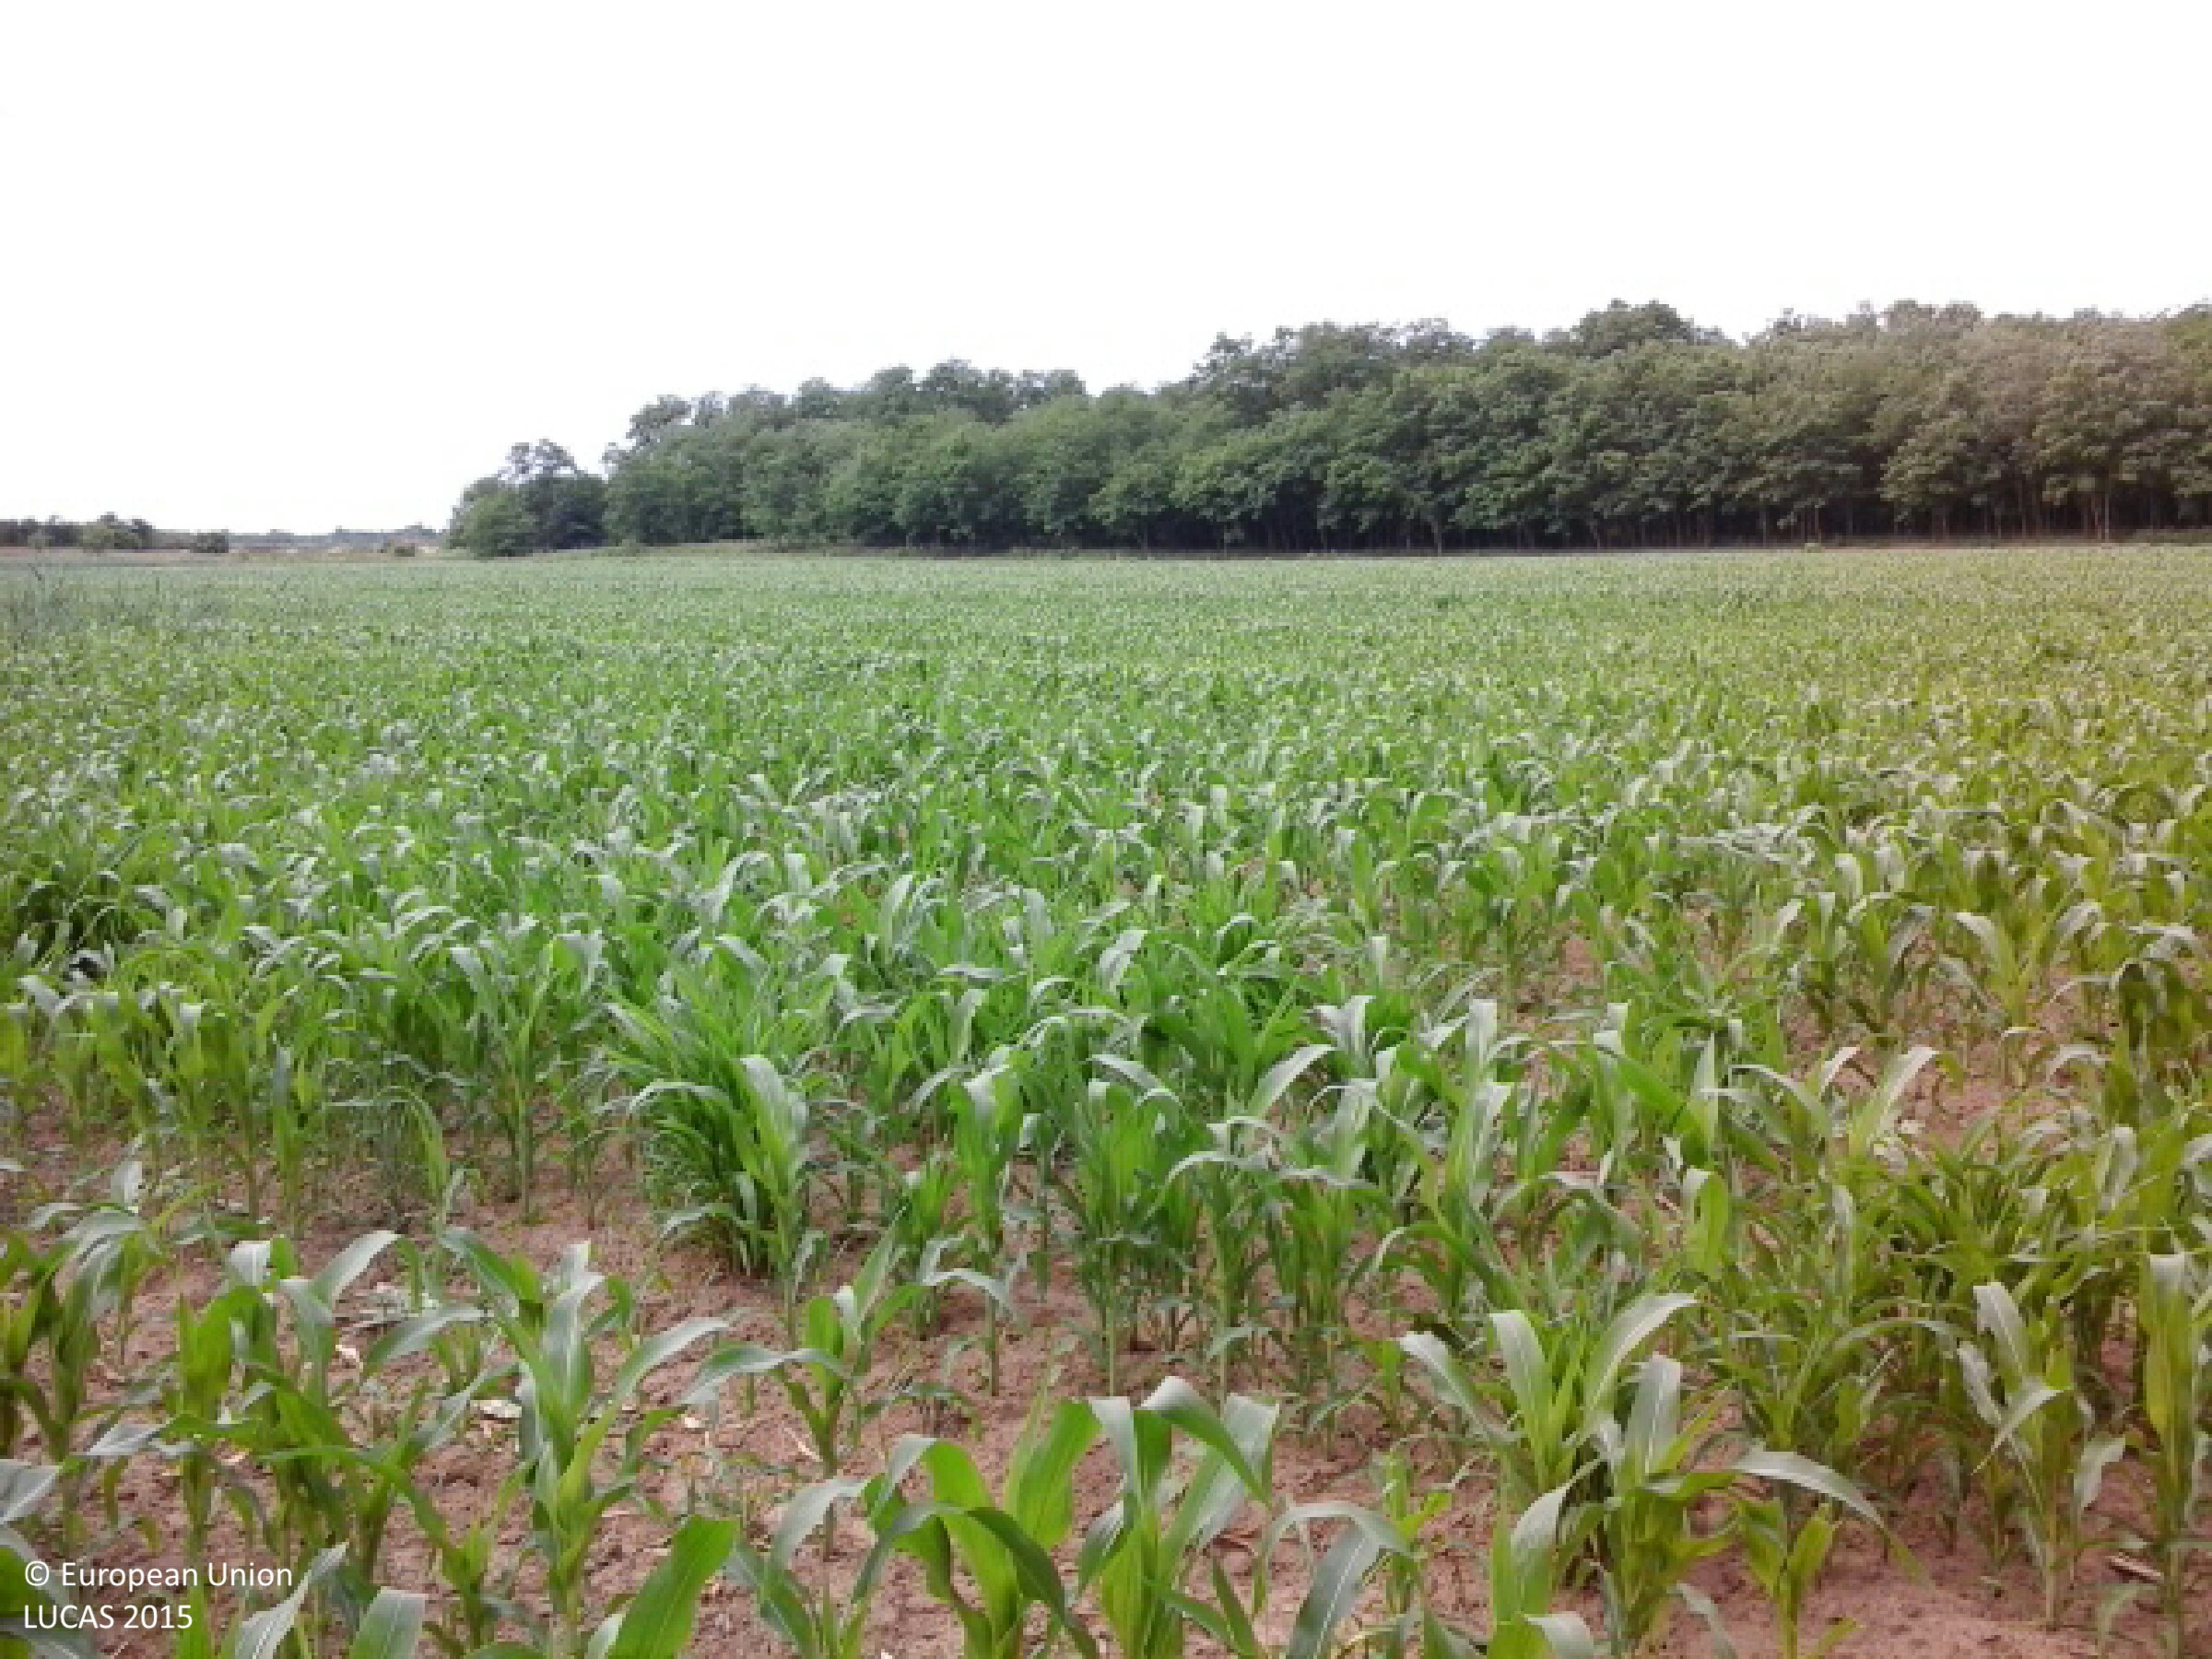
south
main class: Cropland
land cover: Maize
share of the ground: 10 - 25 %
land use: Agriculture (excluding fallow land and kitchen gardens)
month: June
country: HU
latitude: 48.0079
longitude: 21.7780
